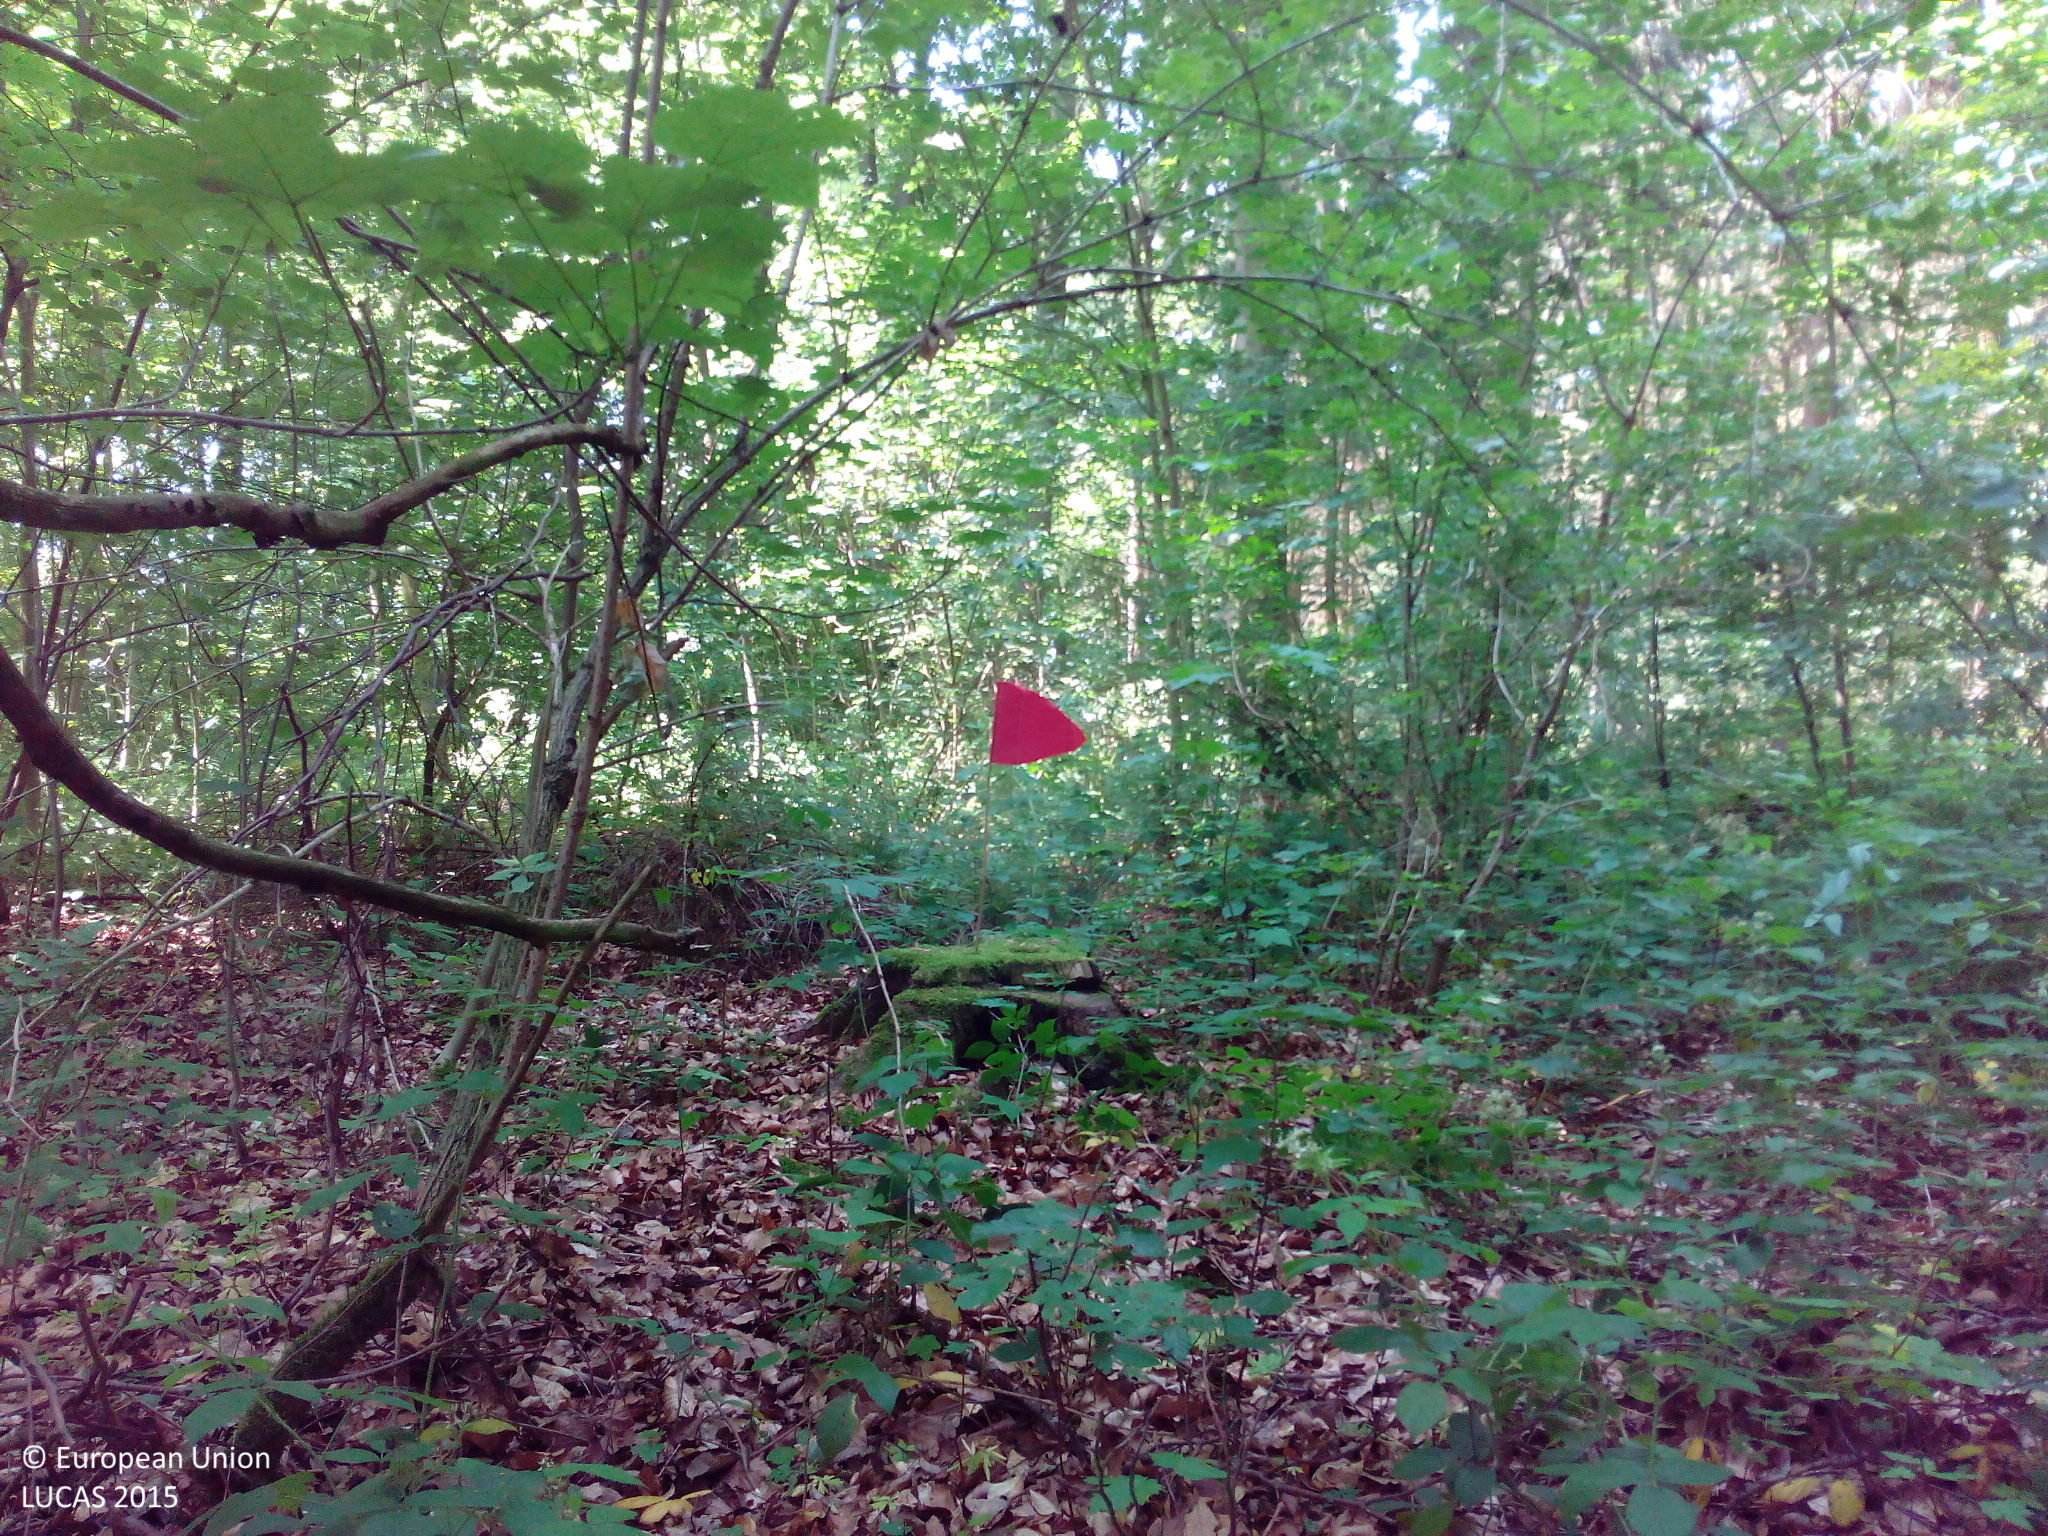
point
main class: Woodland
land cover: Pine dominated mixed woodland
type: hemiboreal forest and nemoral coniferous forest and mixed broadleaved-coniferous forest
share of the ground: > 75 %
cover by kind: broadleaved forest trees 65 %, coniferous forest trees 25 %, shrubs 5 %, herbaceous plants 5 %
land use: Forestry
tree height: > 5 m
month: July
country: DE
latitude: 49.5547
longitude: 9.9033
